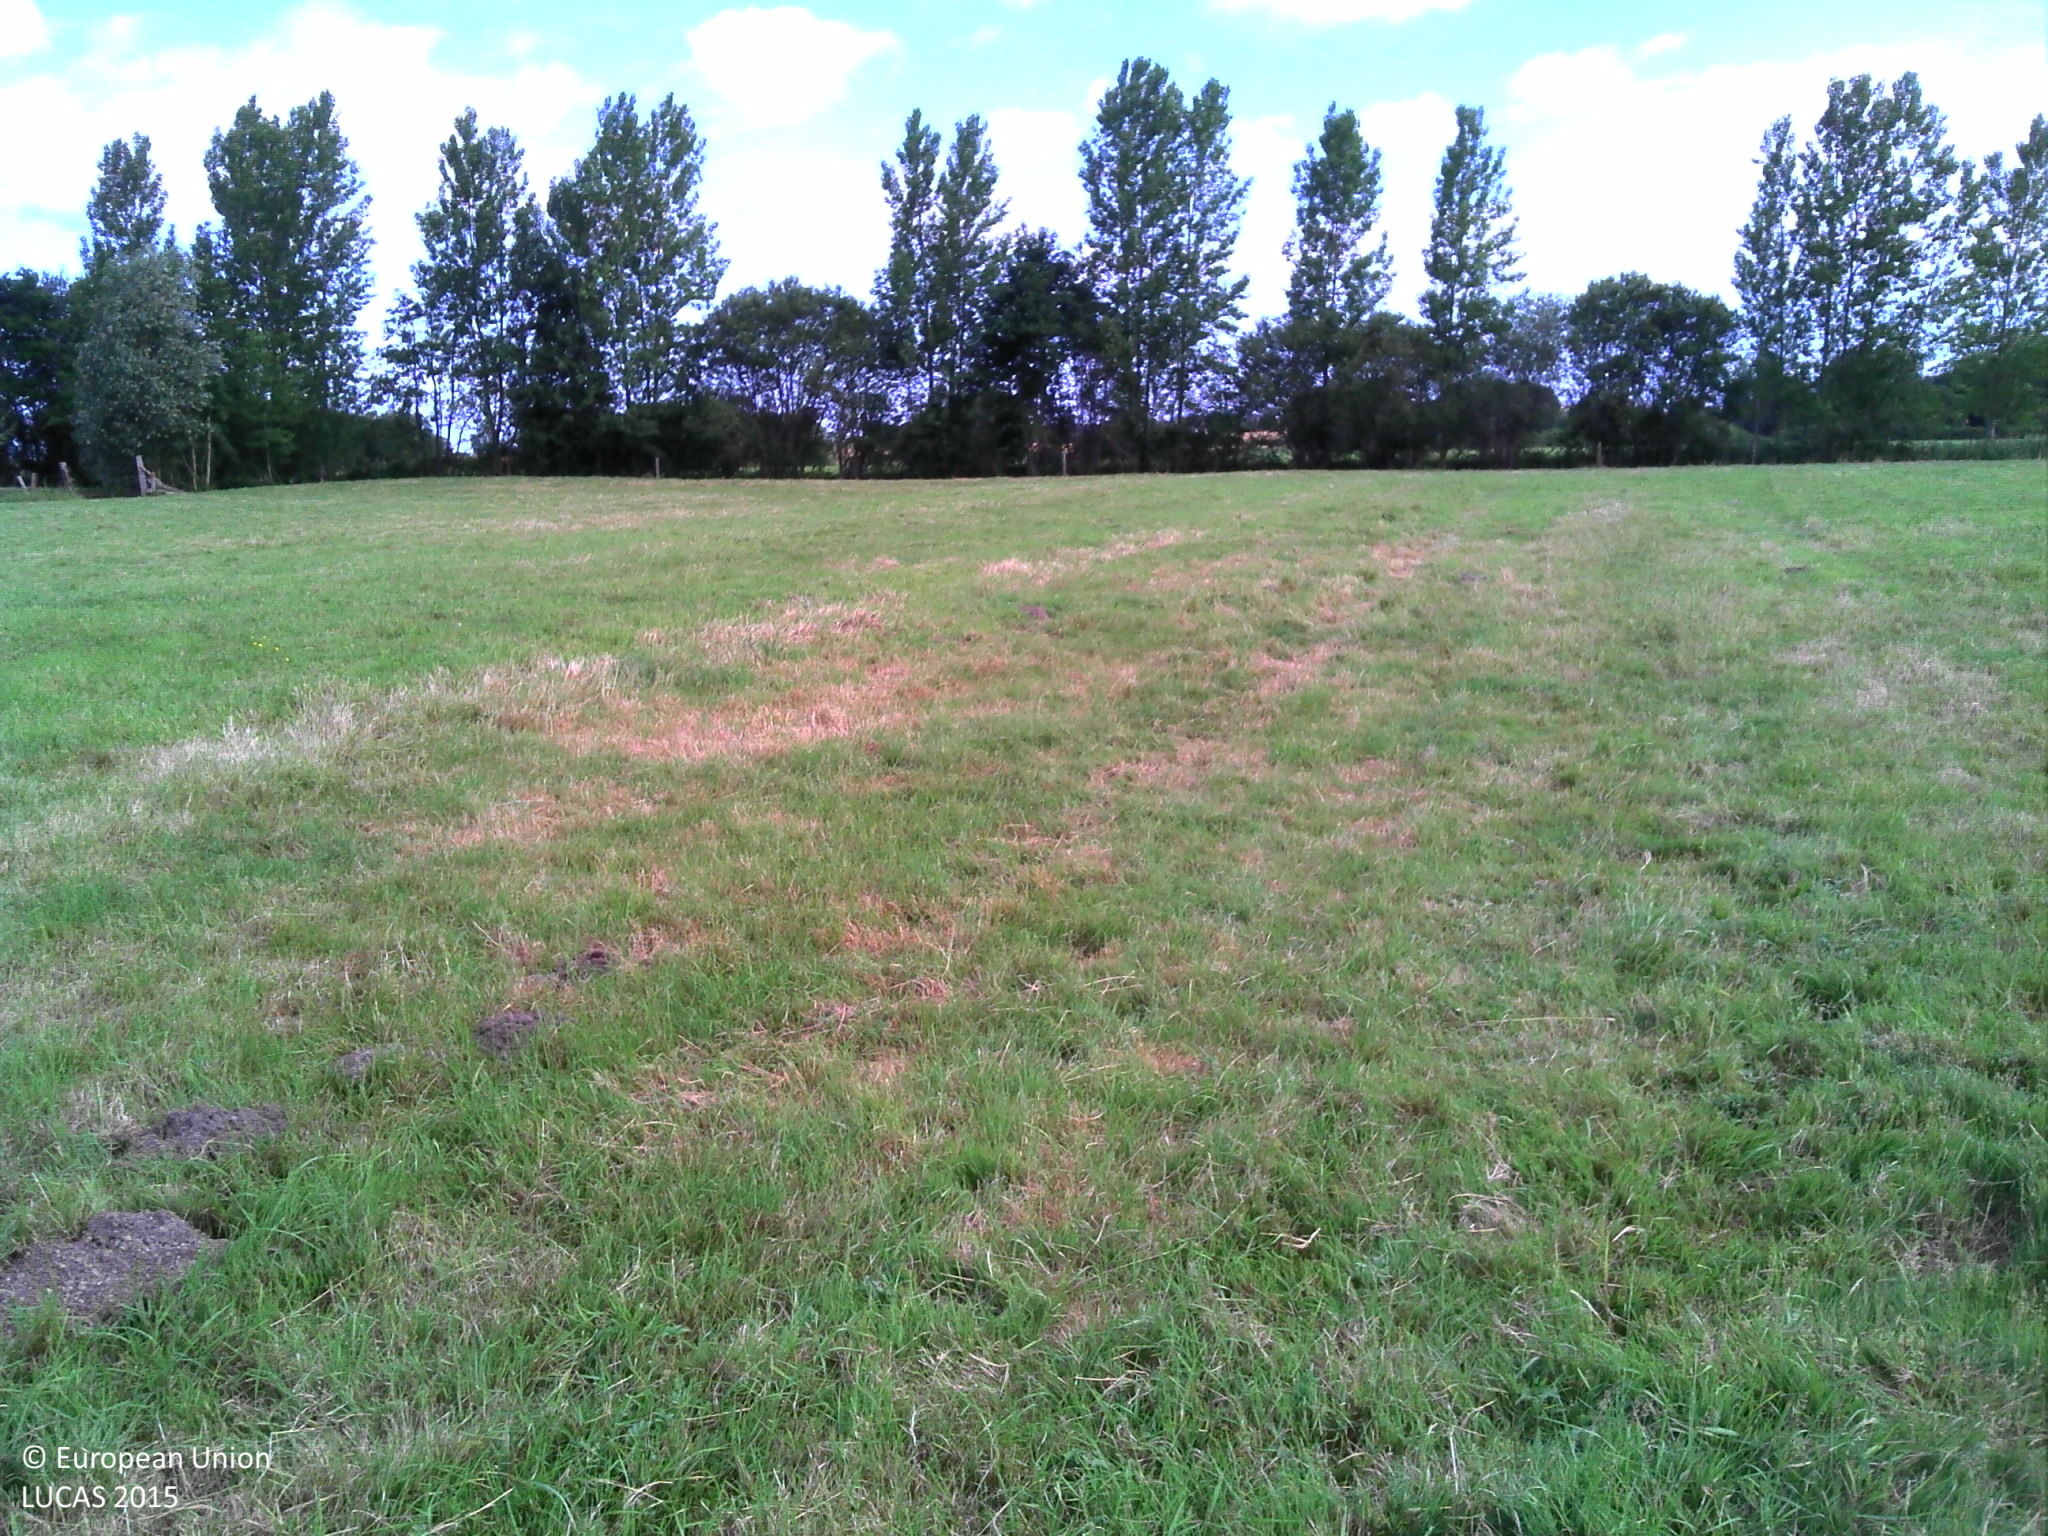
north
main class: Grassland
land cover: Grassland without tree/shrub cover
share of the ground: > 75 %
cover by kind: herbaceous plants 95 %, unconsolidated bare surface 5 %
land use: Agriculture (excluding fallow land and kitchen gardens)
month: July
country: FR
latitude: 48.5666
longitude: -2.1581
